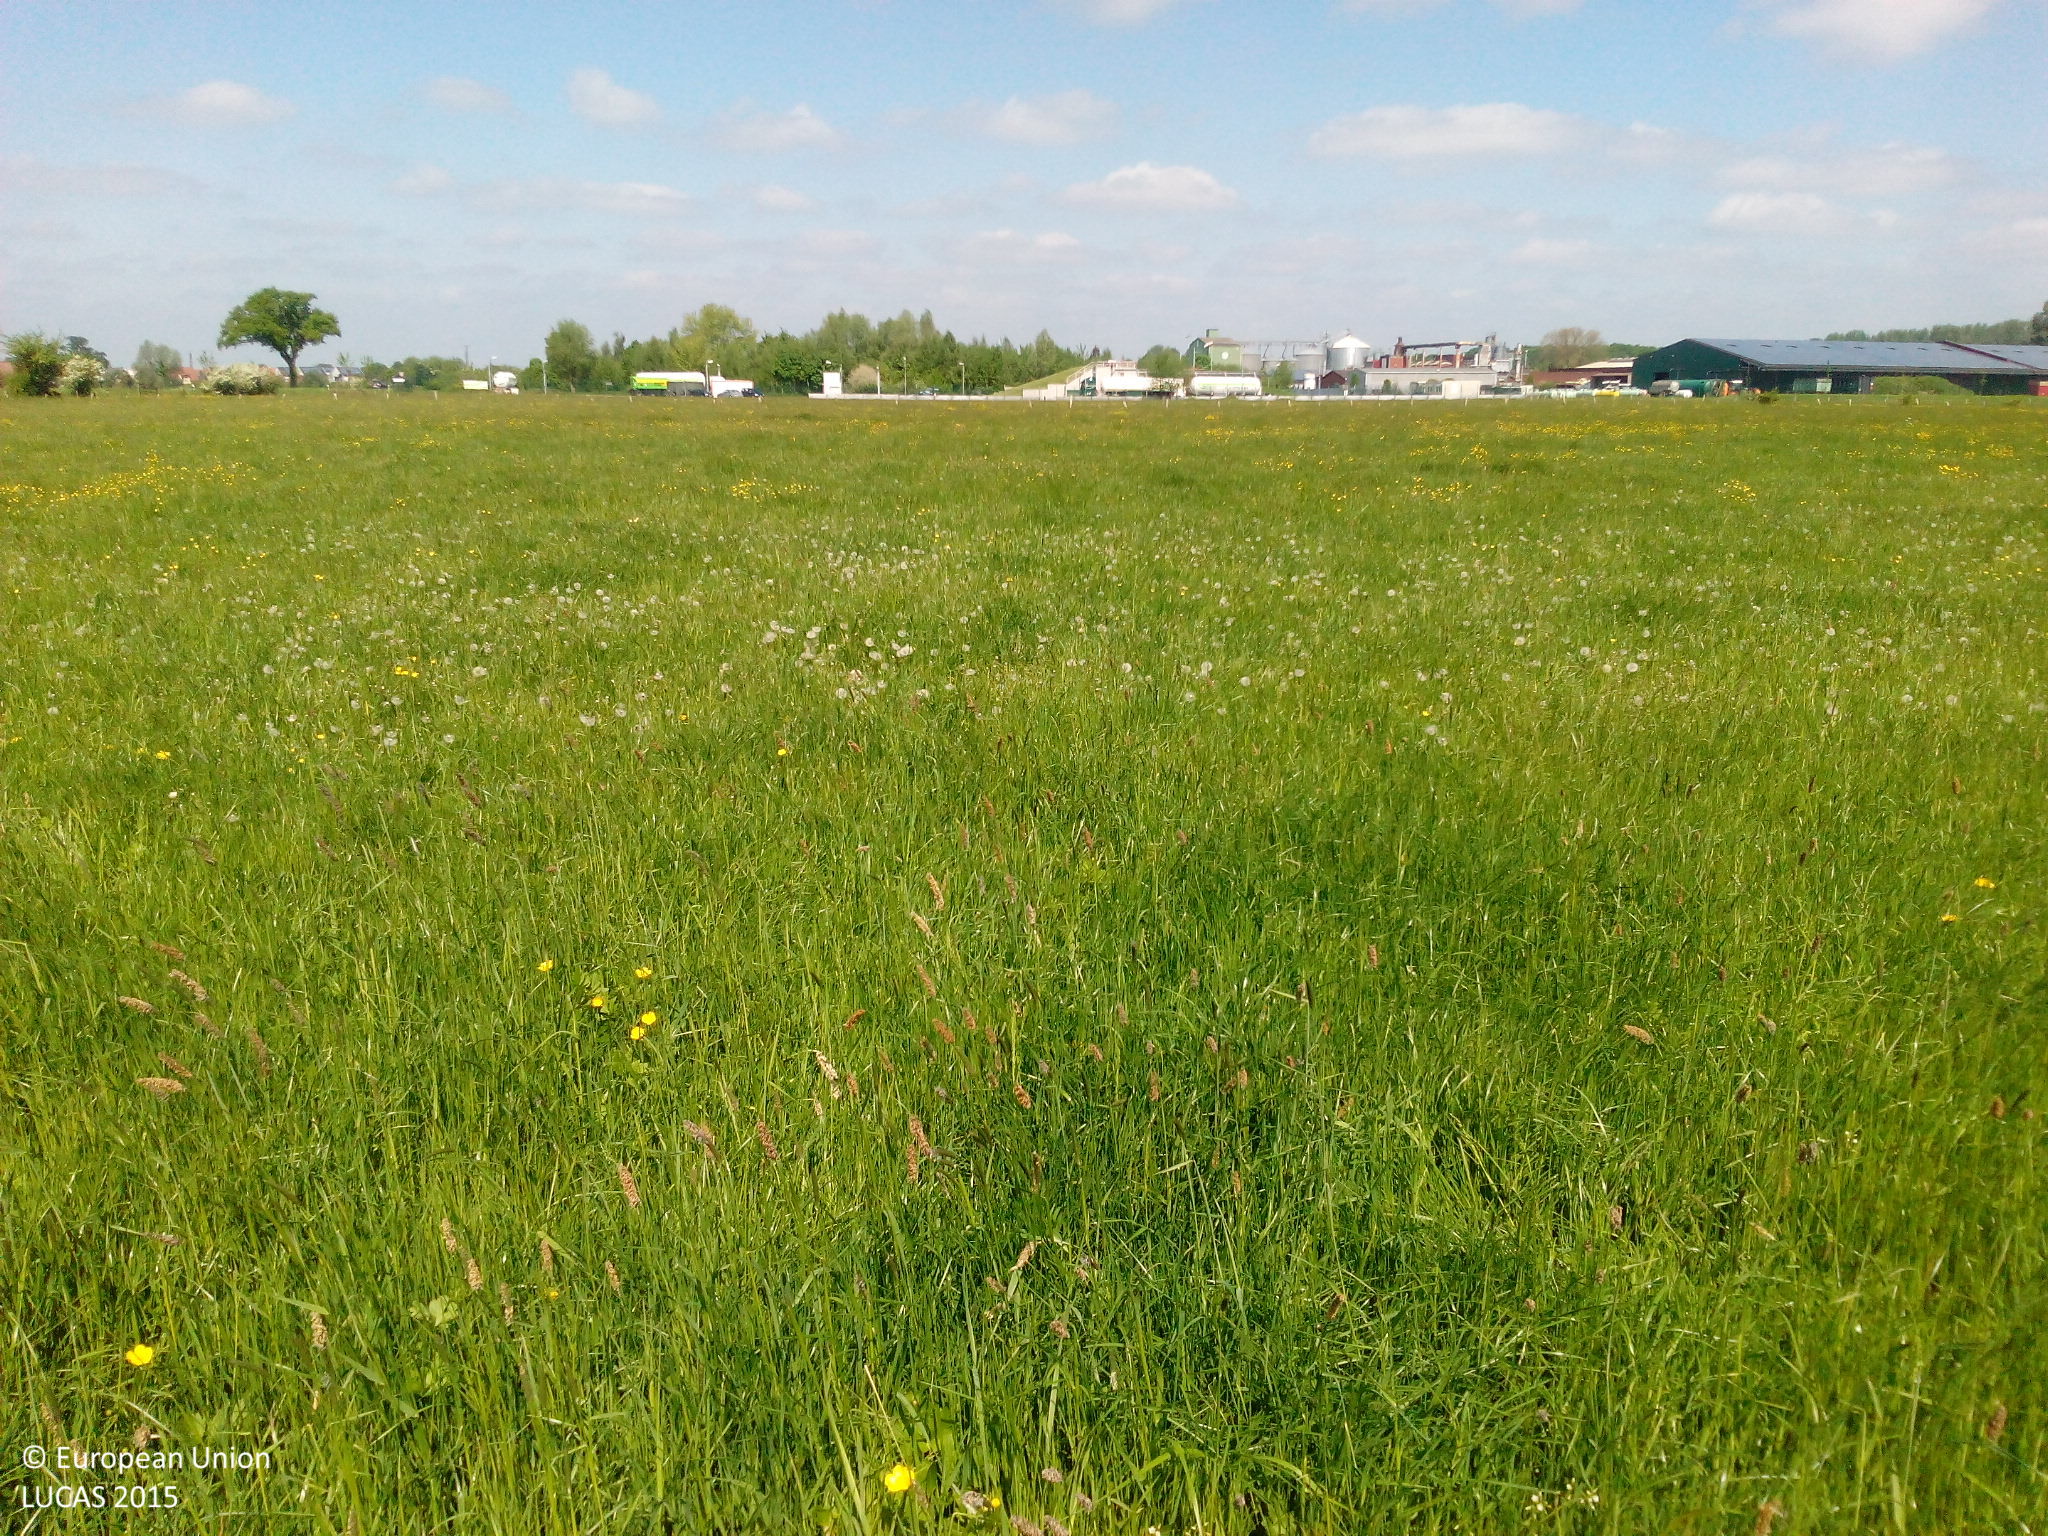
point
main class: Grassland
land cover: Grassland without tree/shrub cover
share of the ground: > 75 %
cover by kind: herbaceous plants 100 %
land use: Agriculture (excluding fallow land and kitchen gardens)
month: May
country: DE
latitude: 51.9108
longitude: 7.9798
